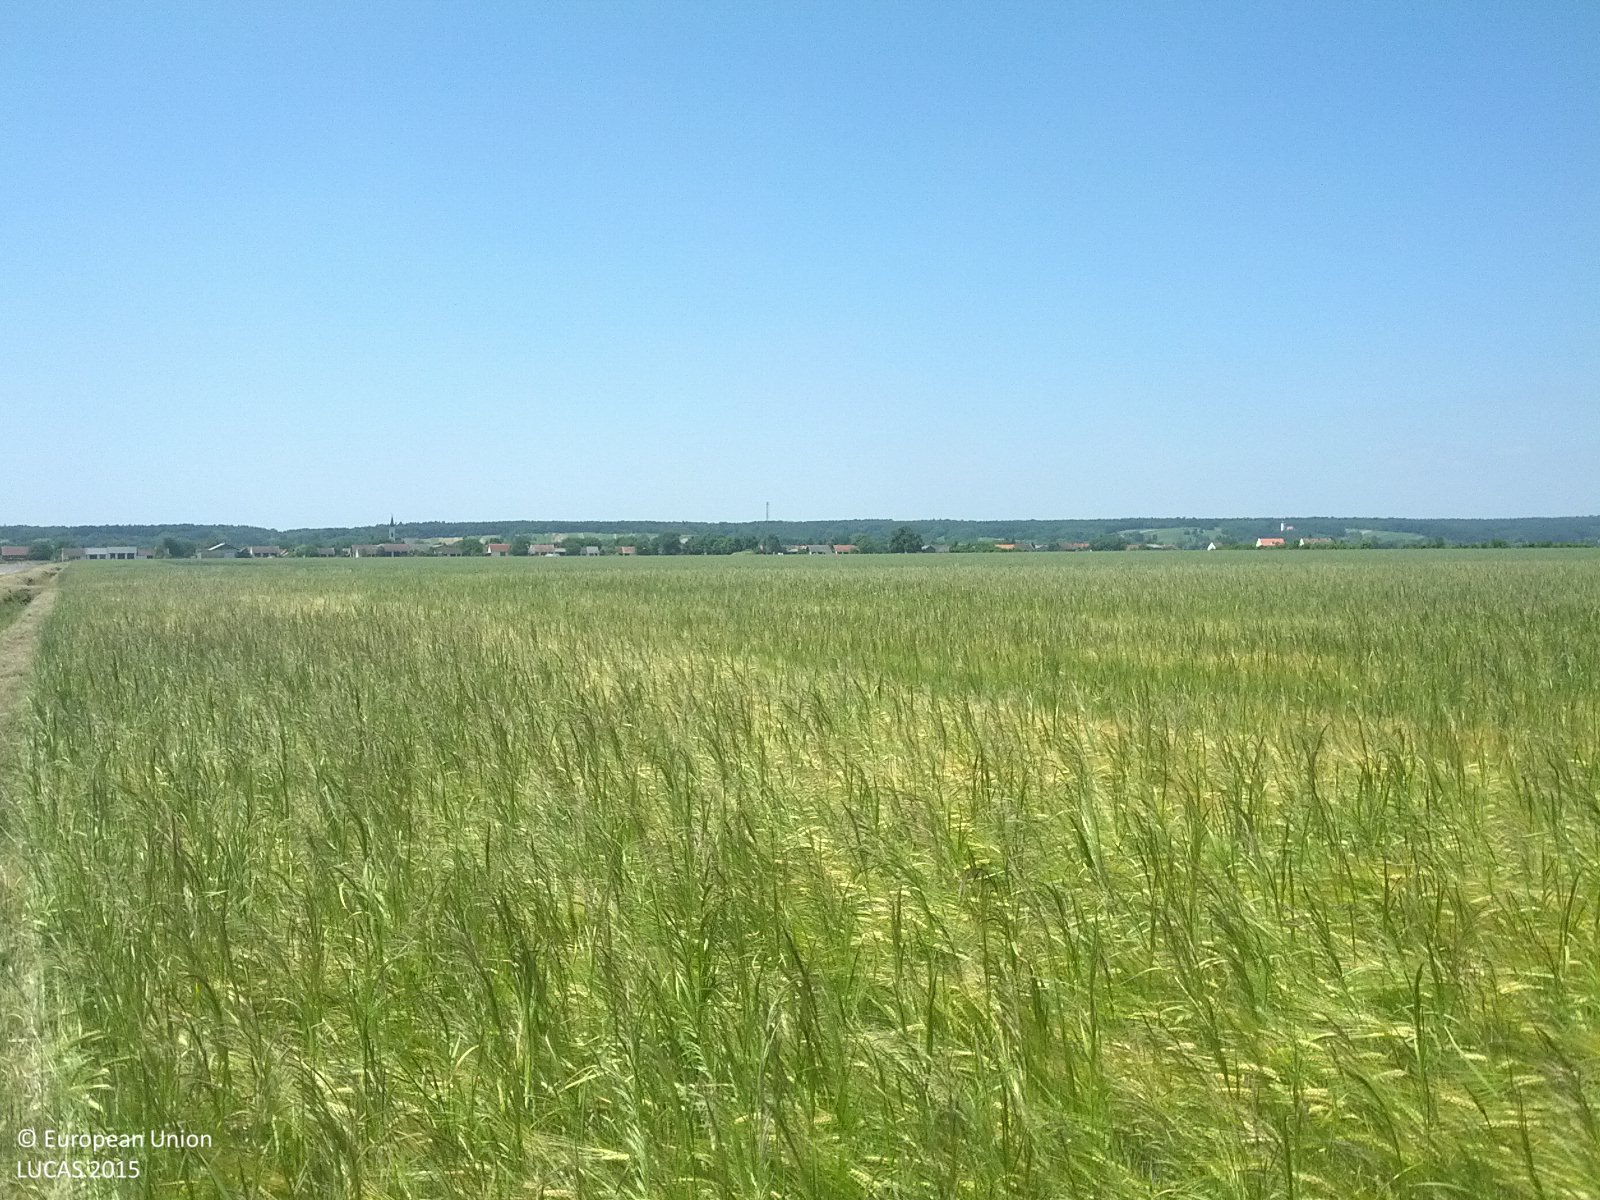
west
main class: Cropland
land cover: Barley
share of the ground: > 75 %
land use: Agriculture (excluding fallow land and kitchen gardens)
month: June
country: AT
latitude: 47.0571
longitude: 16.4931
